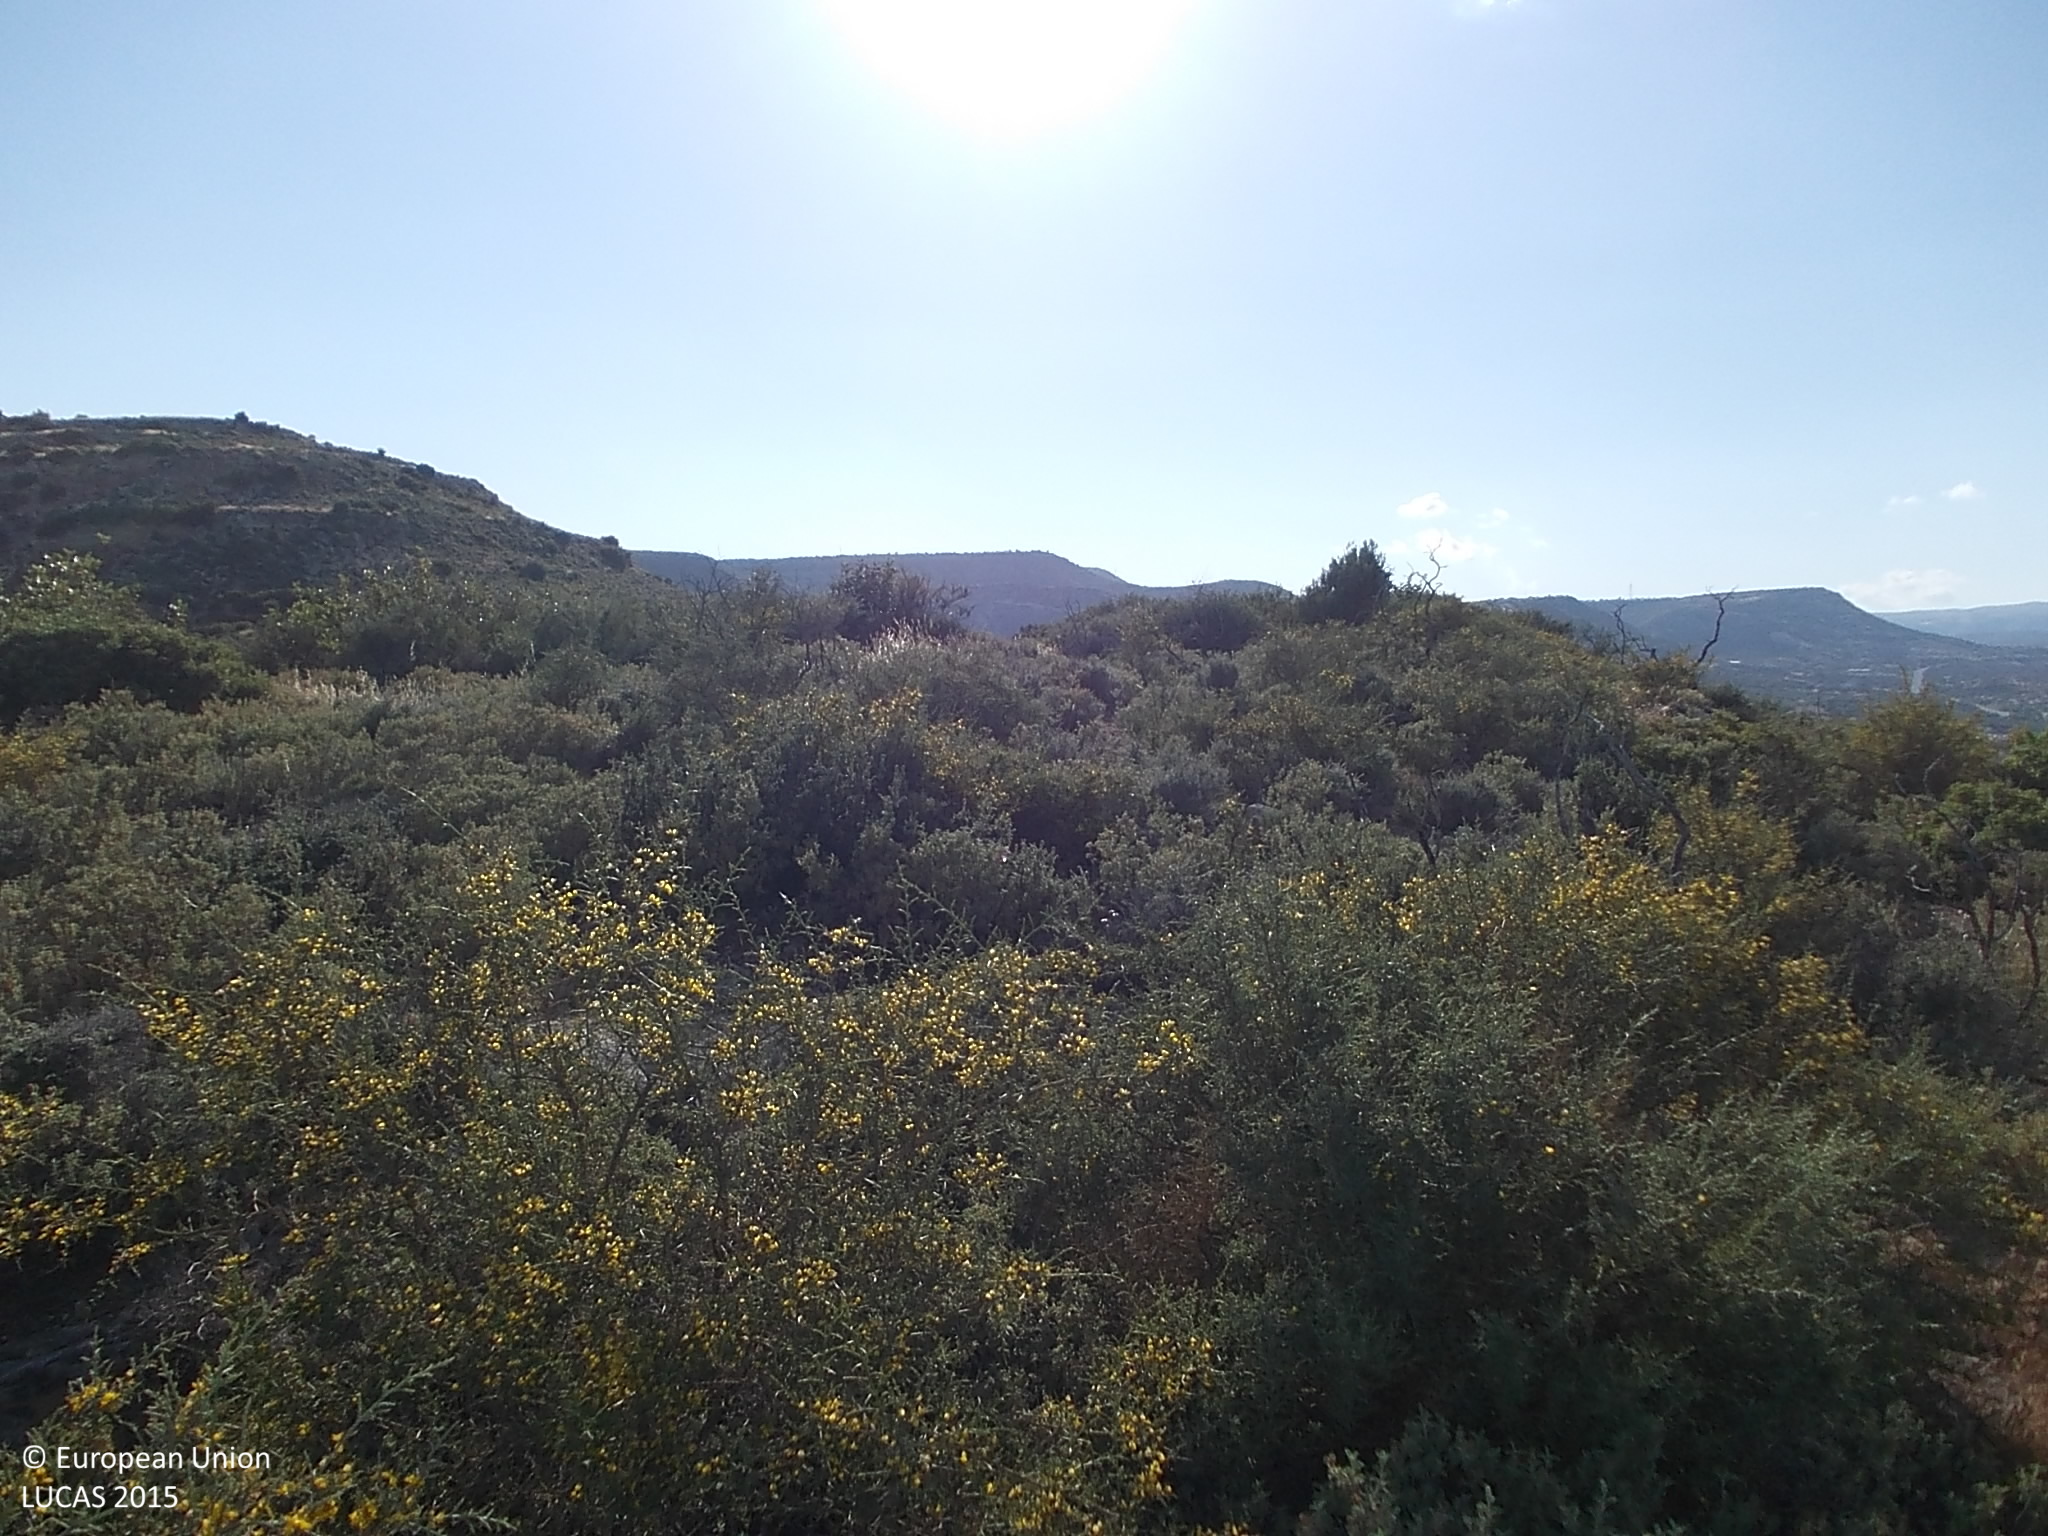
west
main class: Shrubland
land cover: Shrubland without tree cover
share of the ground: 50 - 75 %
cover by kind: shrubs 60 %, unconsolidated bare surface 20 %, herbaceous plants 15 %, consolidated bare surface 5 %
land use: Semi-natural and natural areas not in use
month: May
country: CY
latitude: 34.7424
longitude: 32.9819
